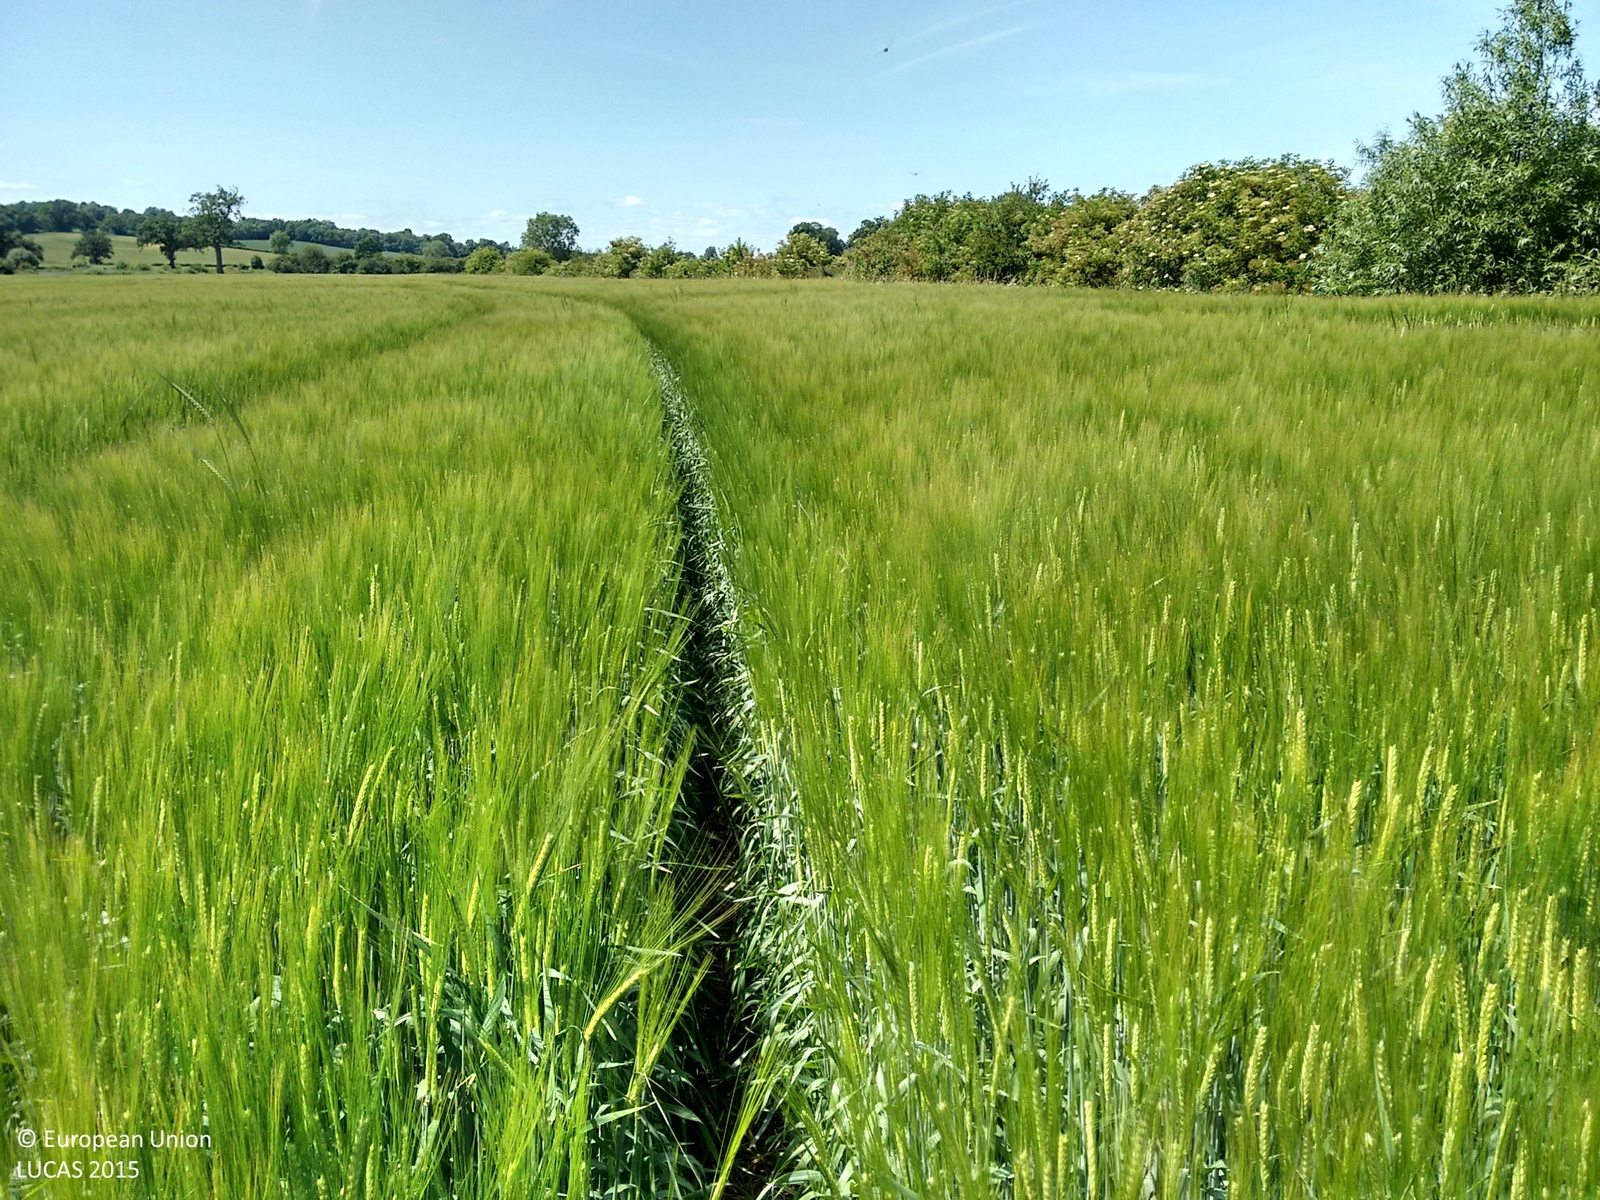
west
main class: Cropland
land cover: Barley
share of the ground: > 75 %
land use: Agriculture (excluding fallow land and kitchen gardens)
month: July
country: GB
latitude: 51.9987
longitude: -1.3075
